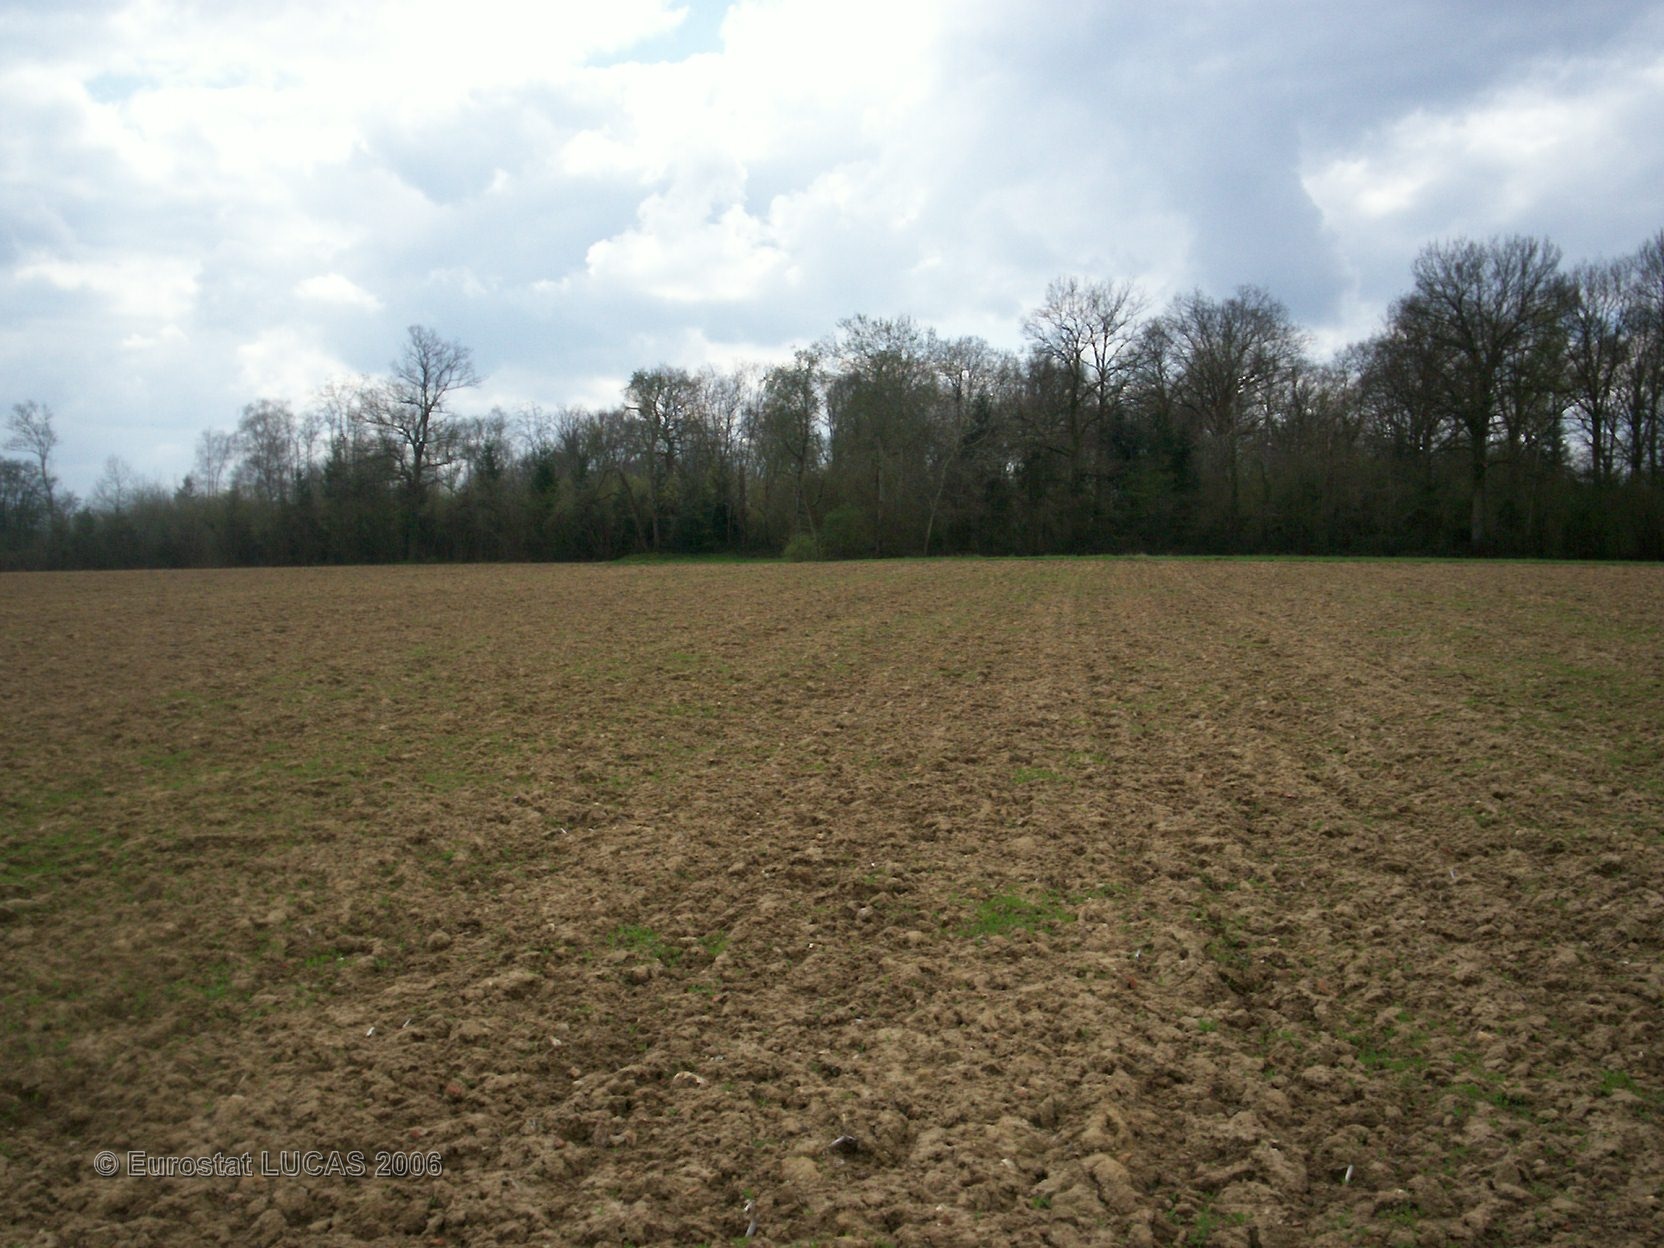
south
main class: Cropland
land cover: Maize
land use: Agriculture (excluding fallow land and kitchen gardens)
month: April
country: FR
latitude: 49.0591
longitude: 0.0480
